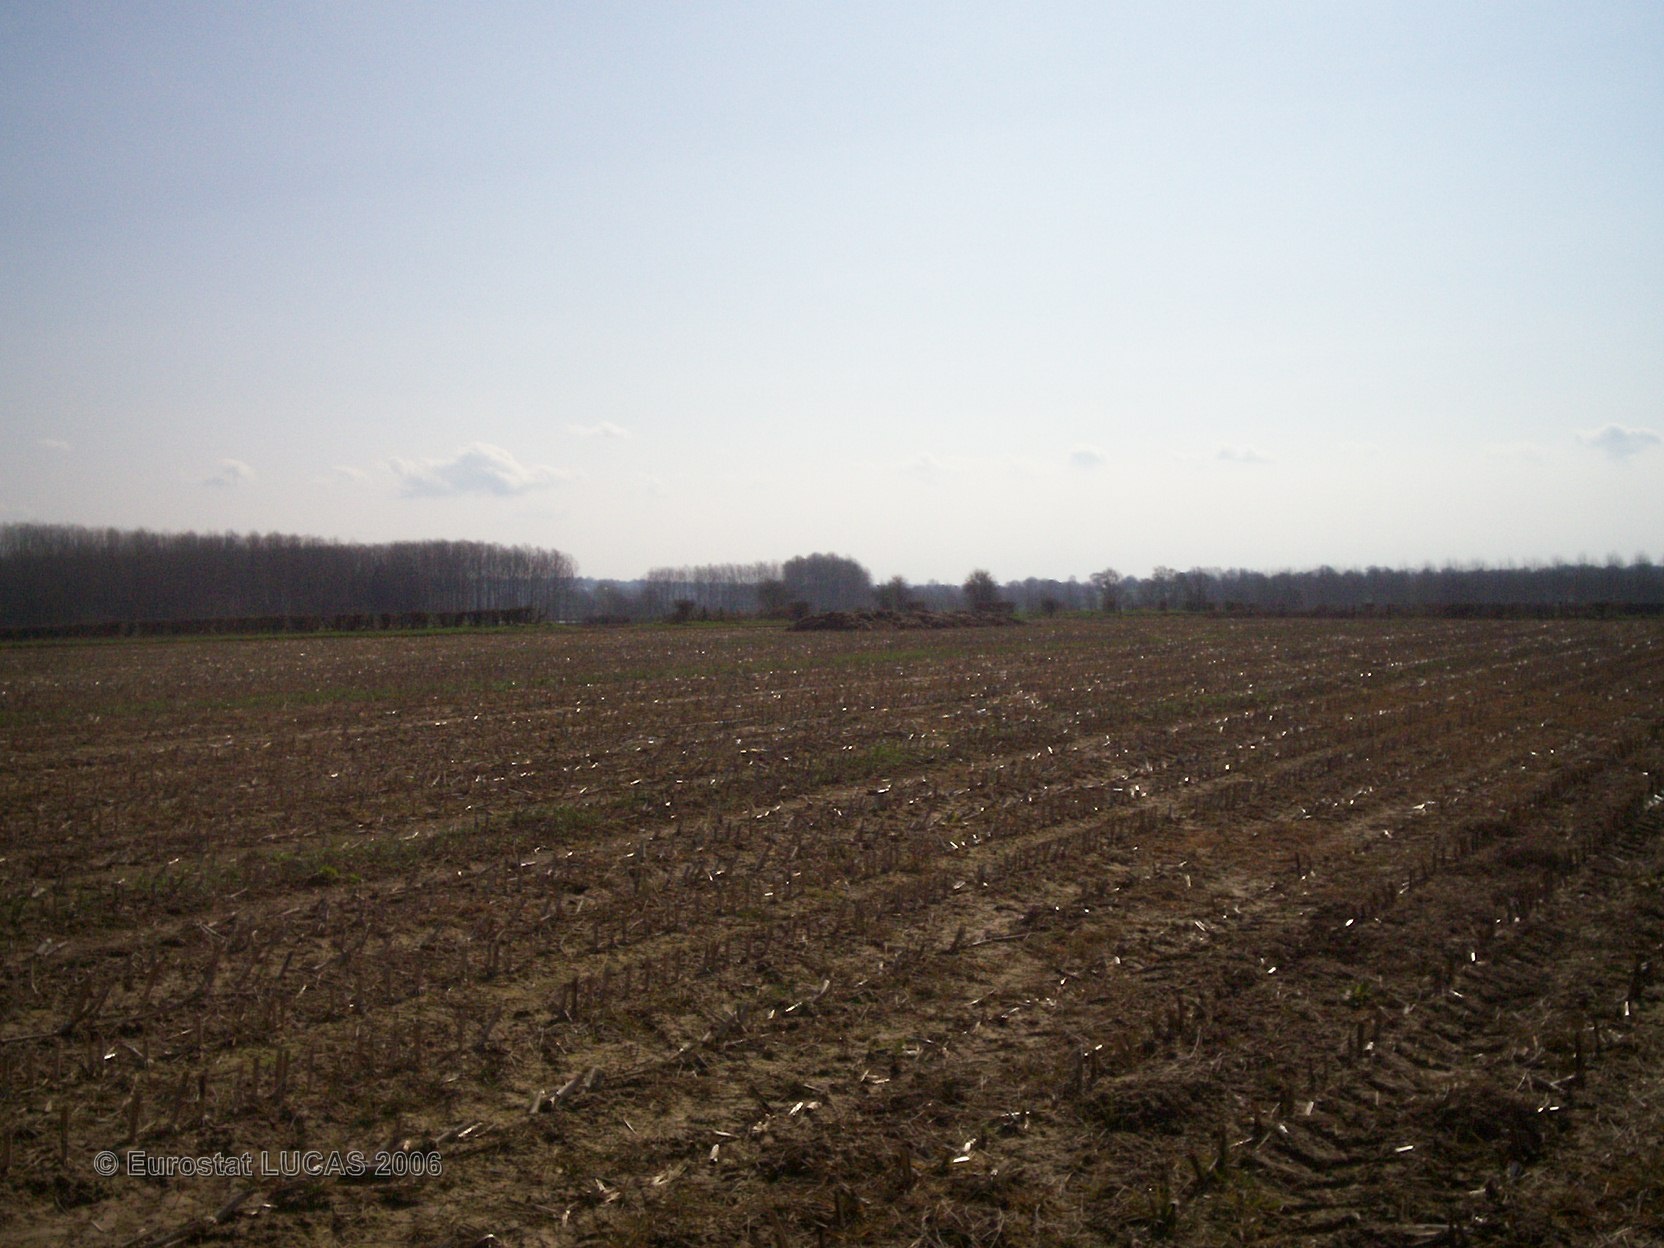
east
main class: Cropland
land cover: Maize
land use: Agriculture (excluding fallow land and kitchen gardens)
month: April
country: FR
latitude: 50.1369
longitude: 3.7113
